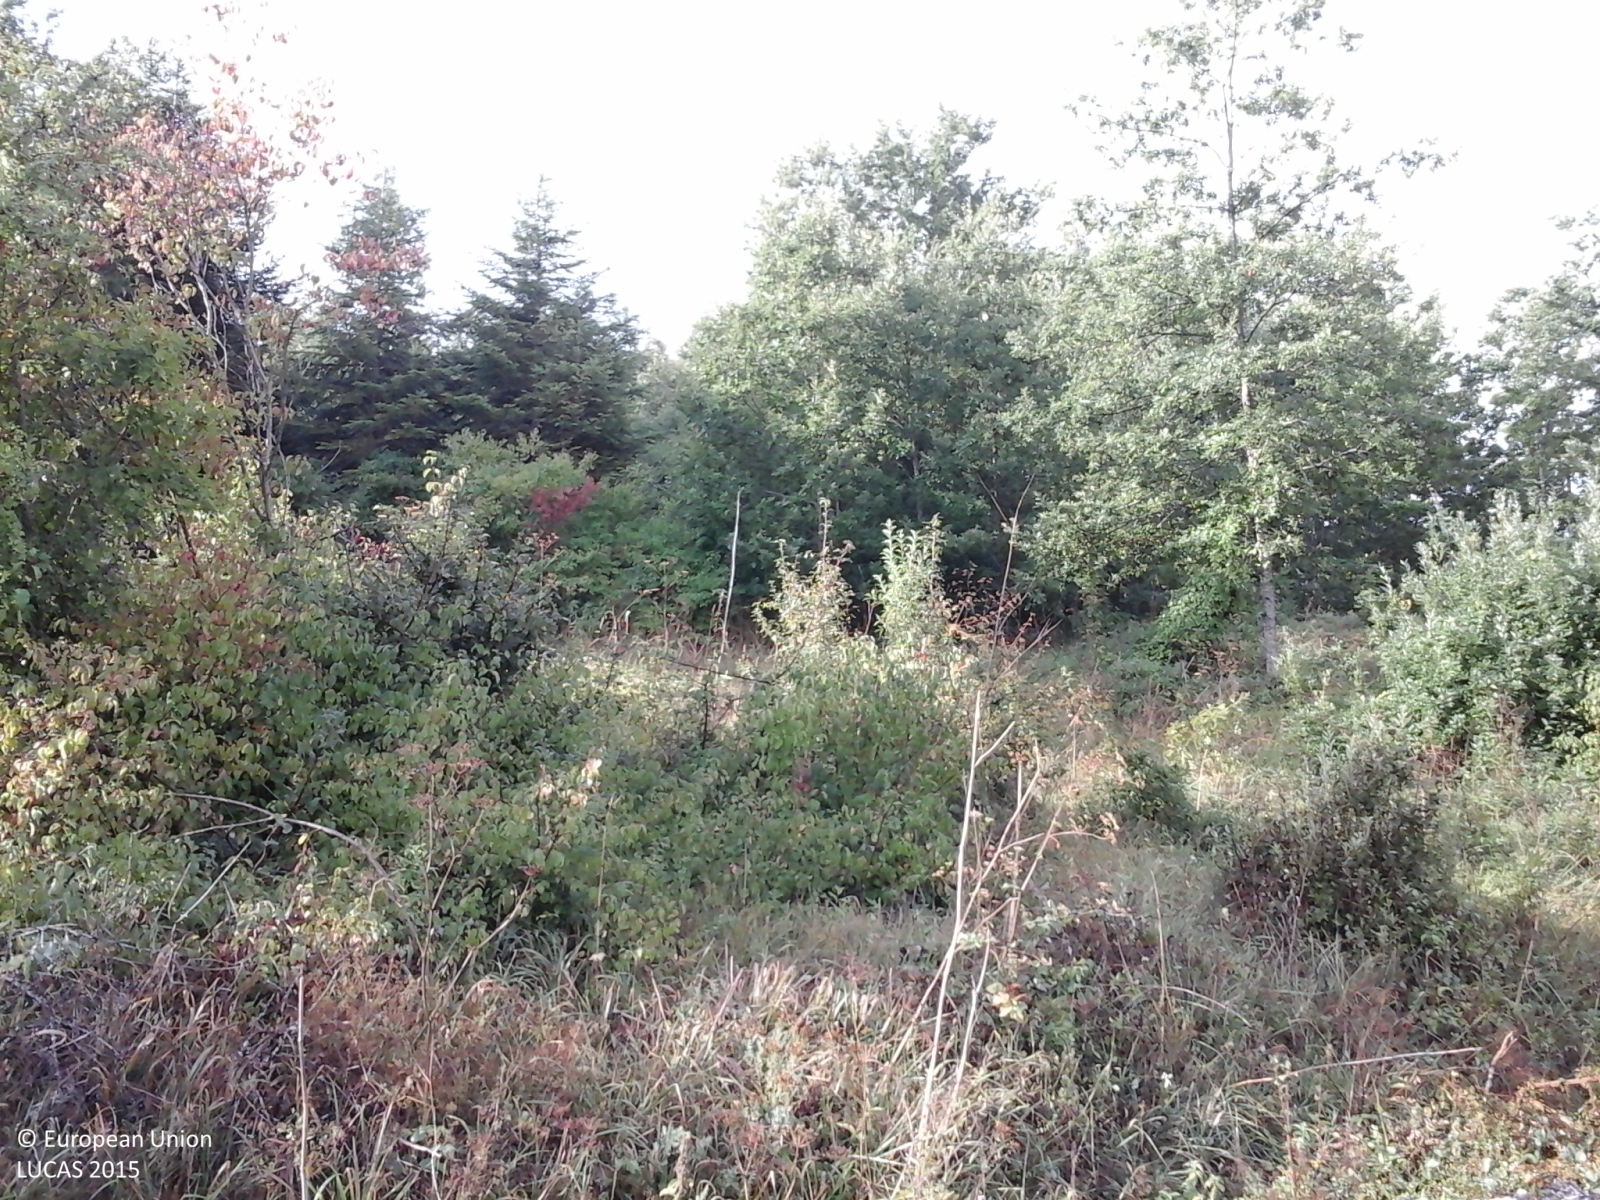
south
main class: Woodland
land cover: Broadleaved woodland
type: thermophilous deciduous forest
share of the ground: > 75 %
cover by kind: broadleaved forest trees 75 %, shrubs 15 %, herbaceous plants 10 %
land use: Forestry
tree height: > 5 m
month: September
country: IT
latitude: 41.7454
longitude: 14.3741
